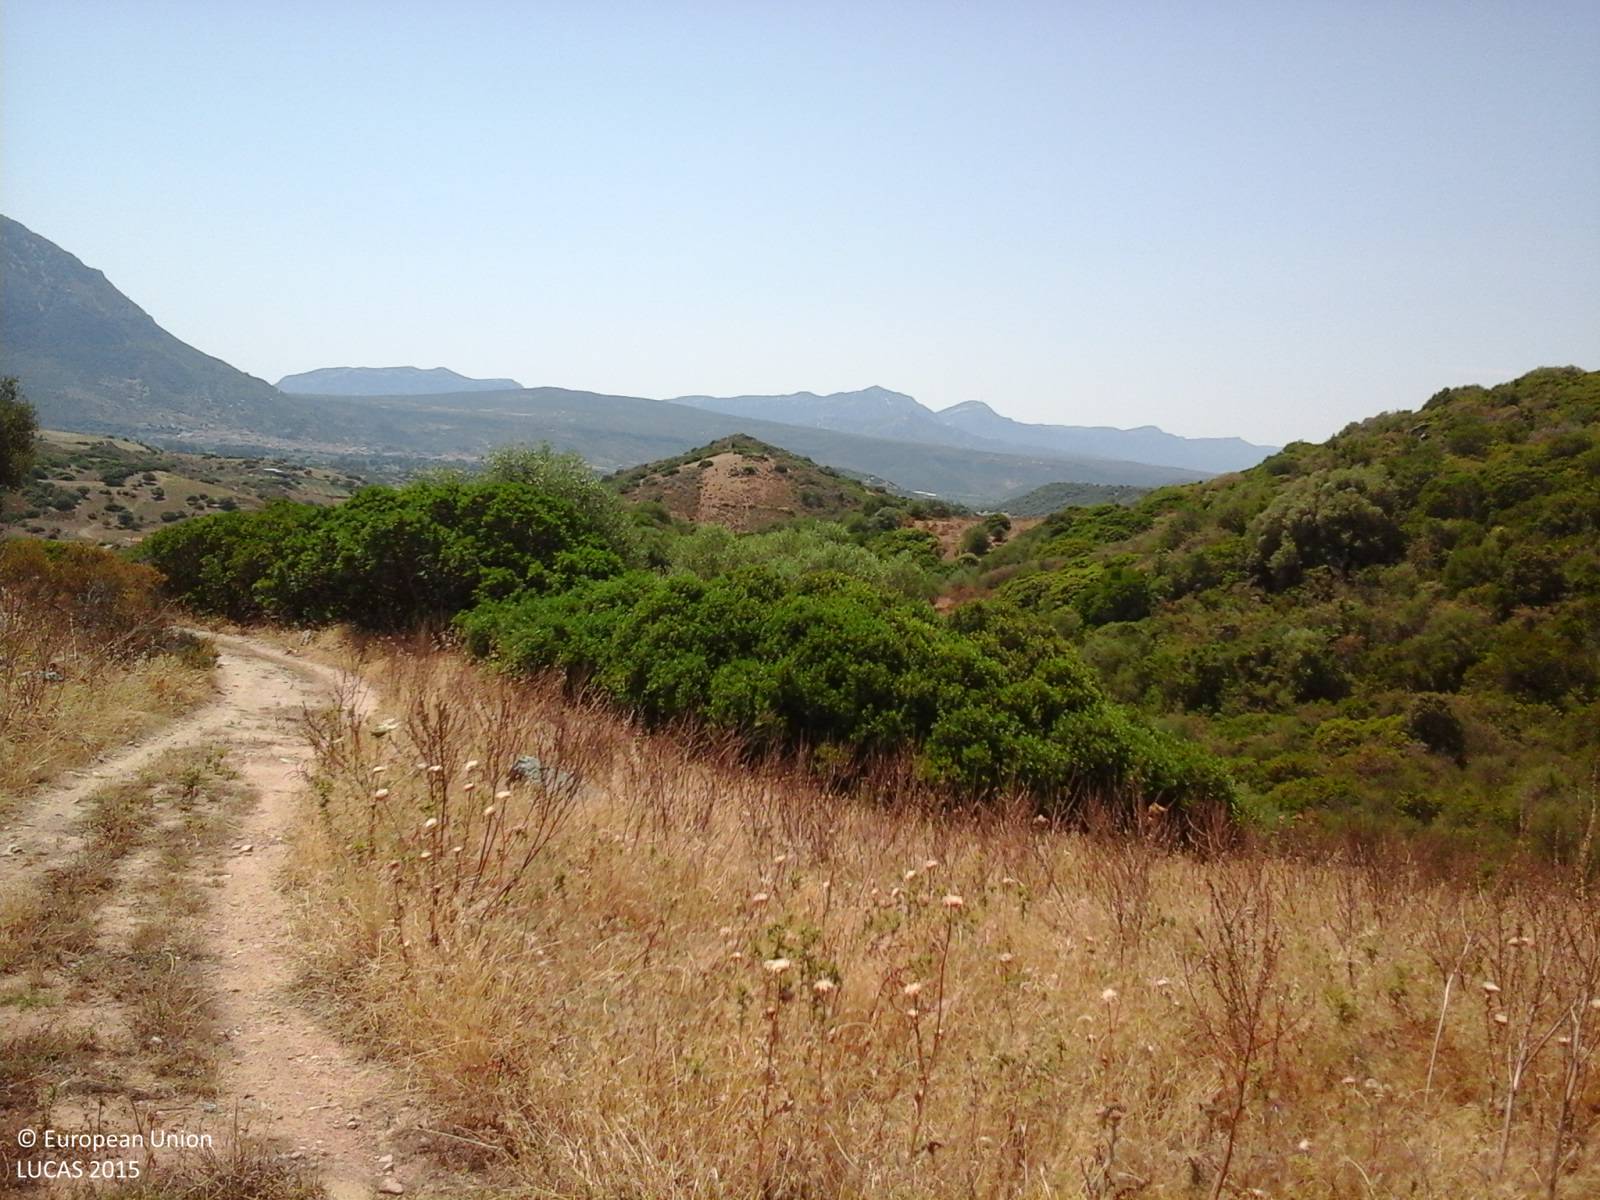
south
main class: Grassland
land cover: Grassland without tree/shrub cover
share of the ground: > 75 %
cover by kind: herbaceous plants 95 %, shrubs 5 %
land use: Agriculture (excluding fallow land and kitchen gardens)
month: June
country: IT
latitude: 40.4294
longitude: 9.5895
